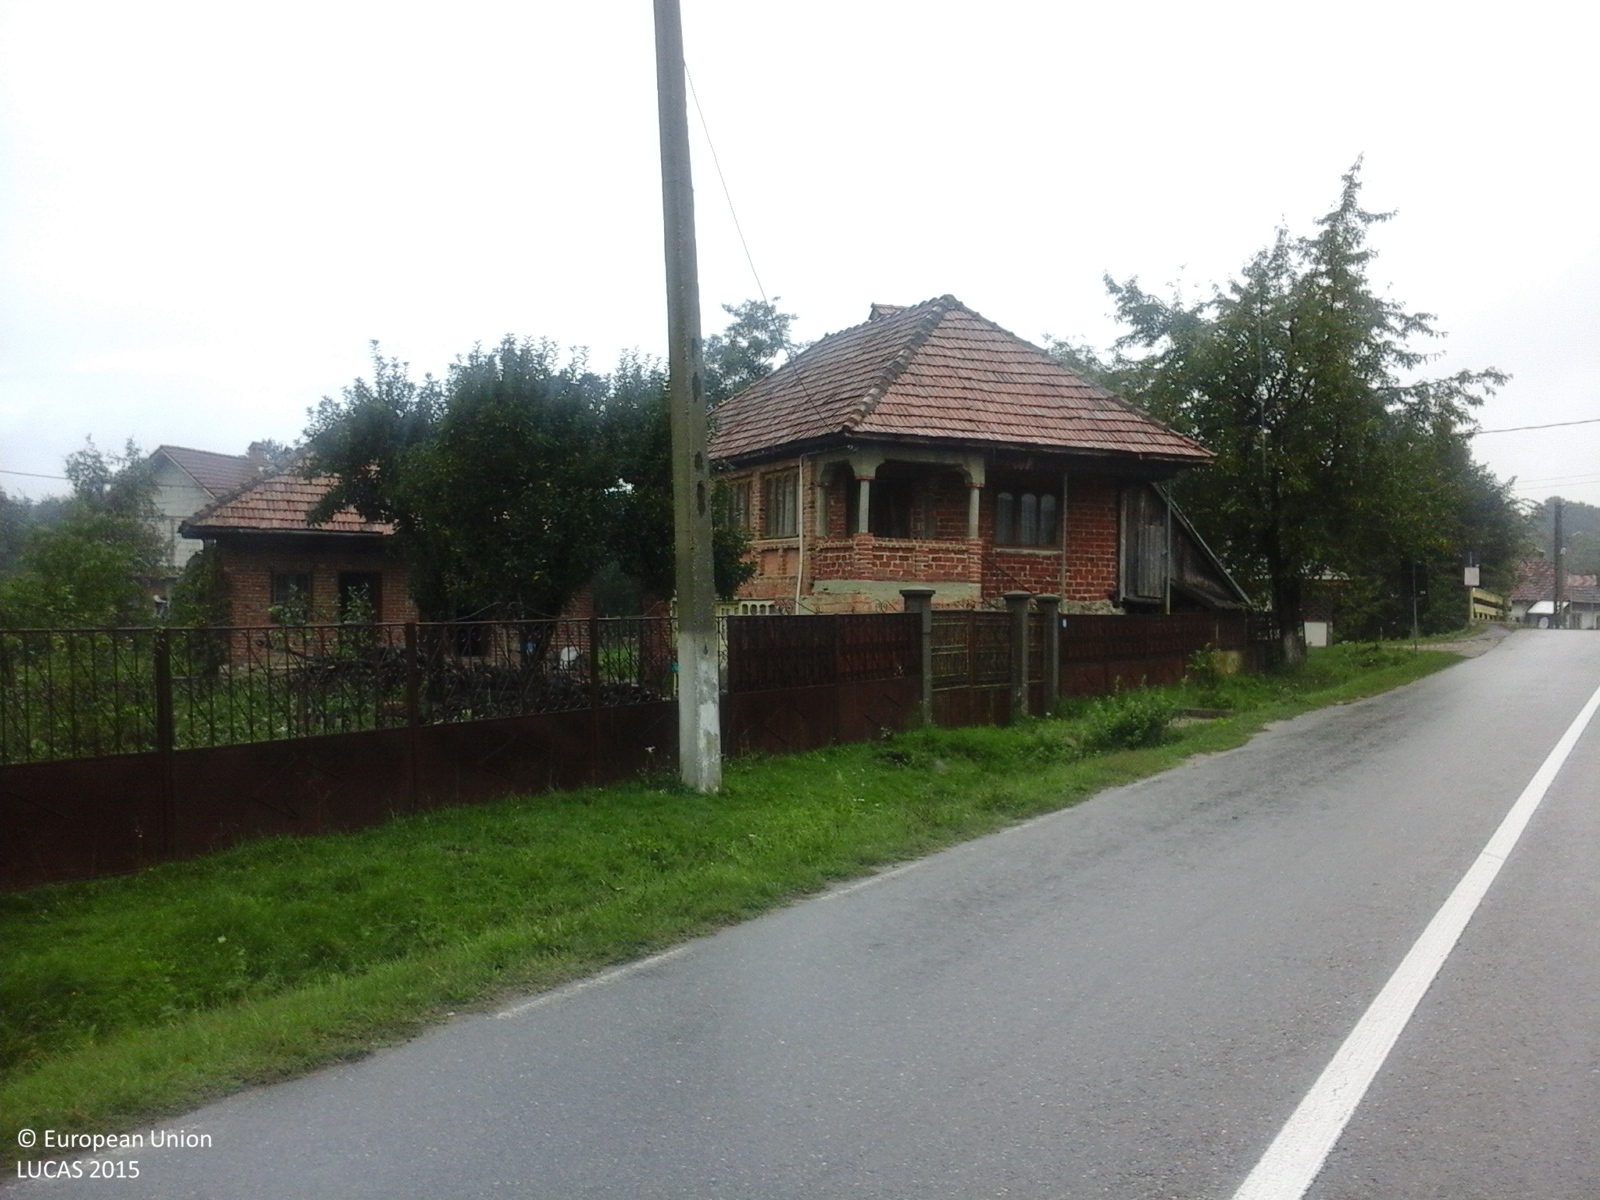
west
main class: Cropland
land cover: Vineyards
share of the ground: 10 - 25 %
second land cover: Grassland without tree/shrub cover
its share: > 75 %
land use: Kitchen garden
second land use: Residential
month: September
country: RO
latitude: 45.1660
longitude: 23.6101
